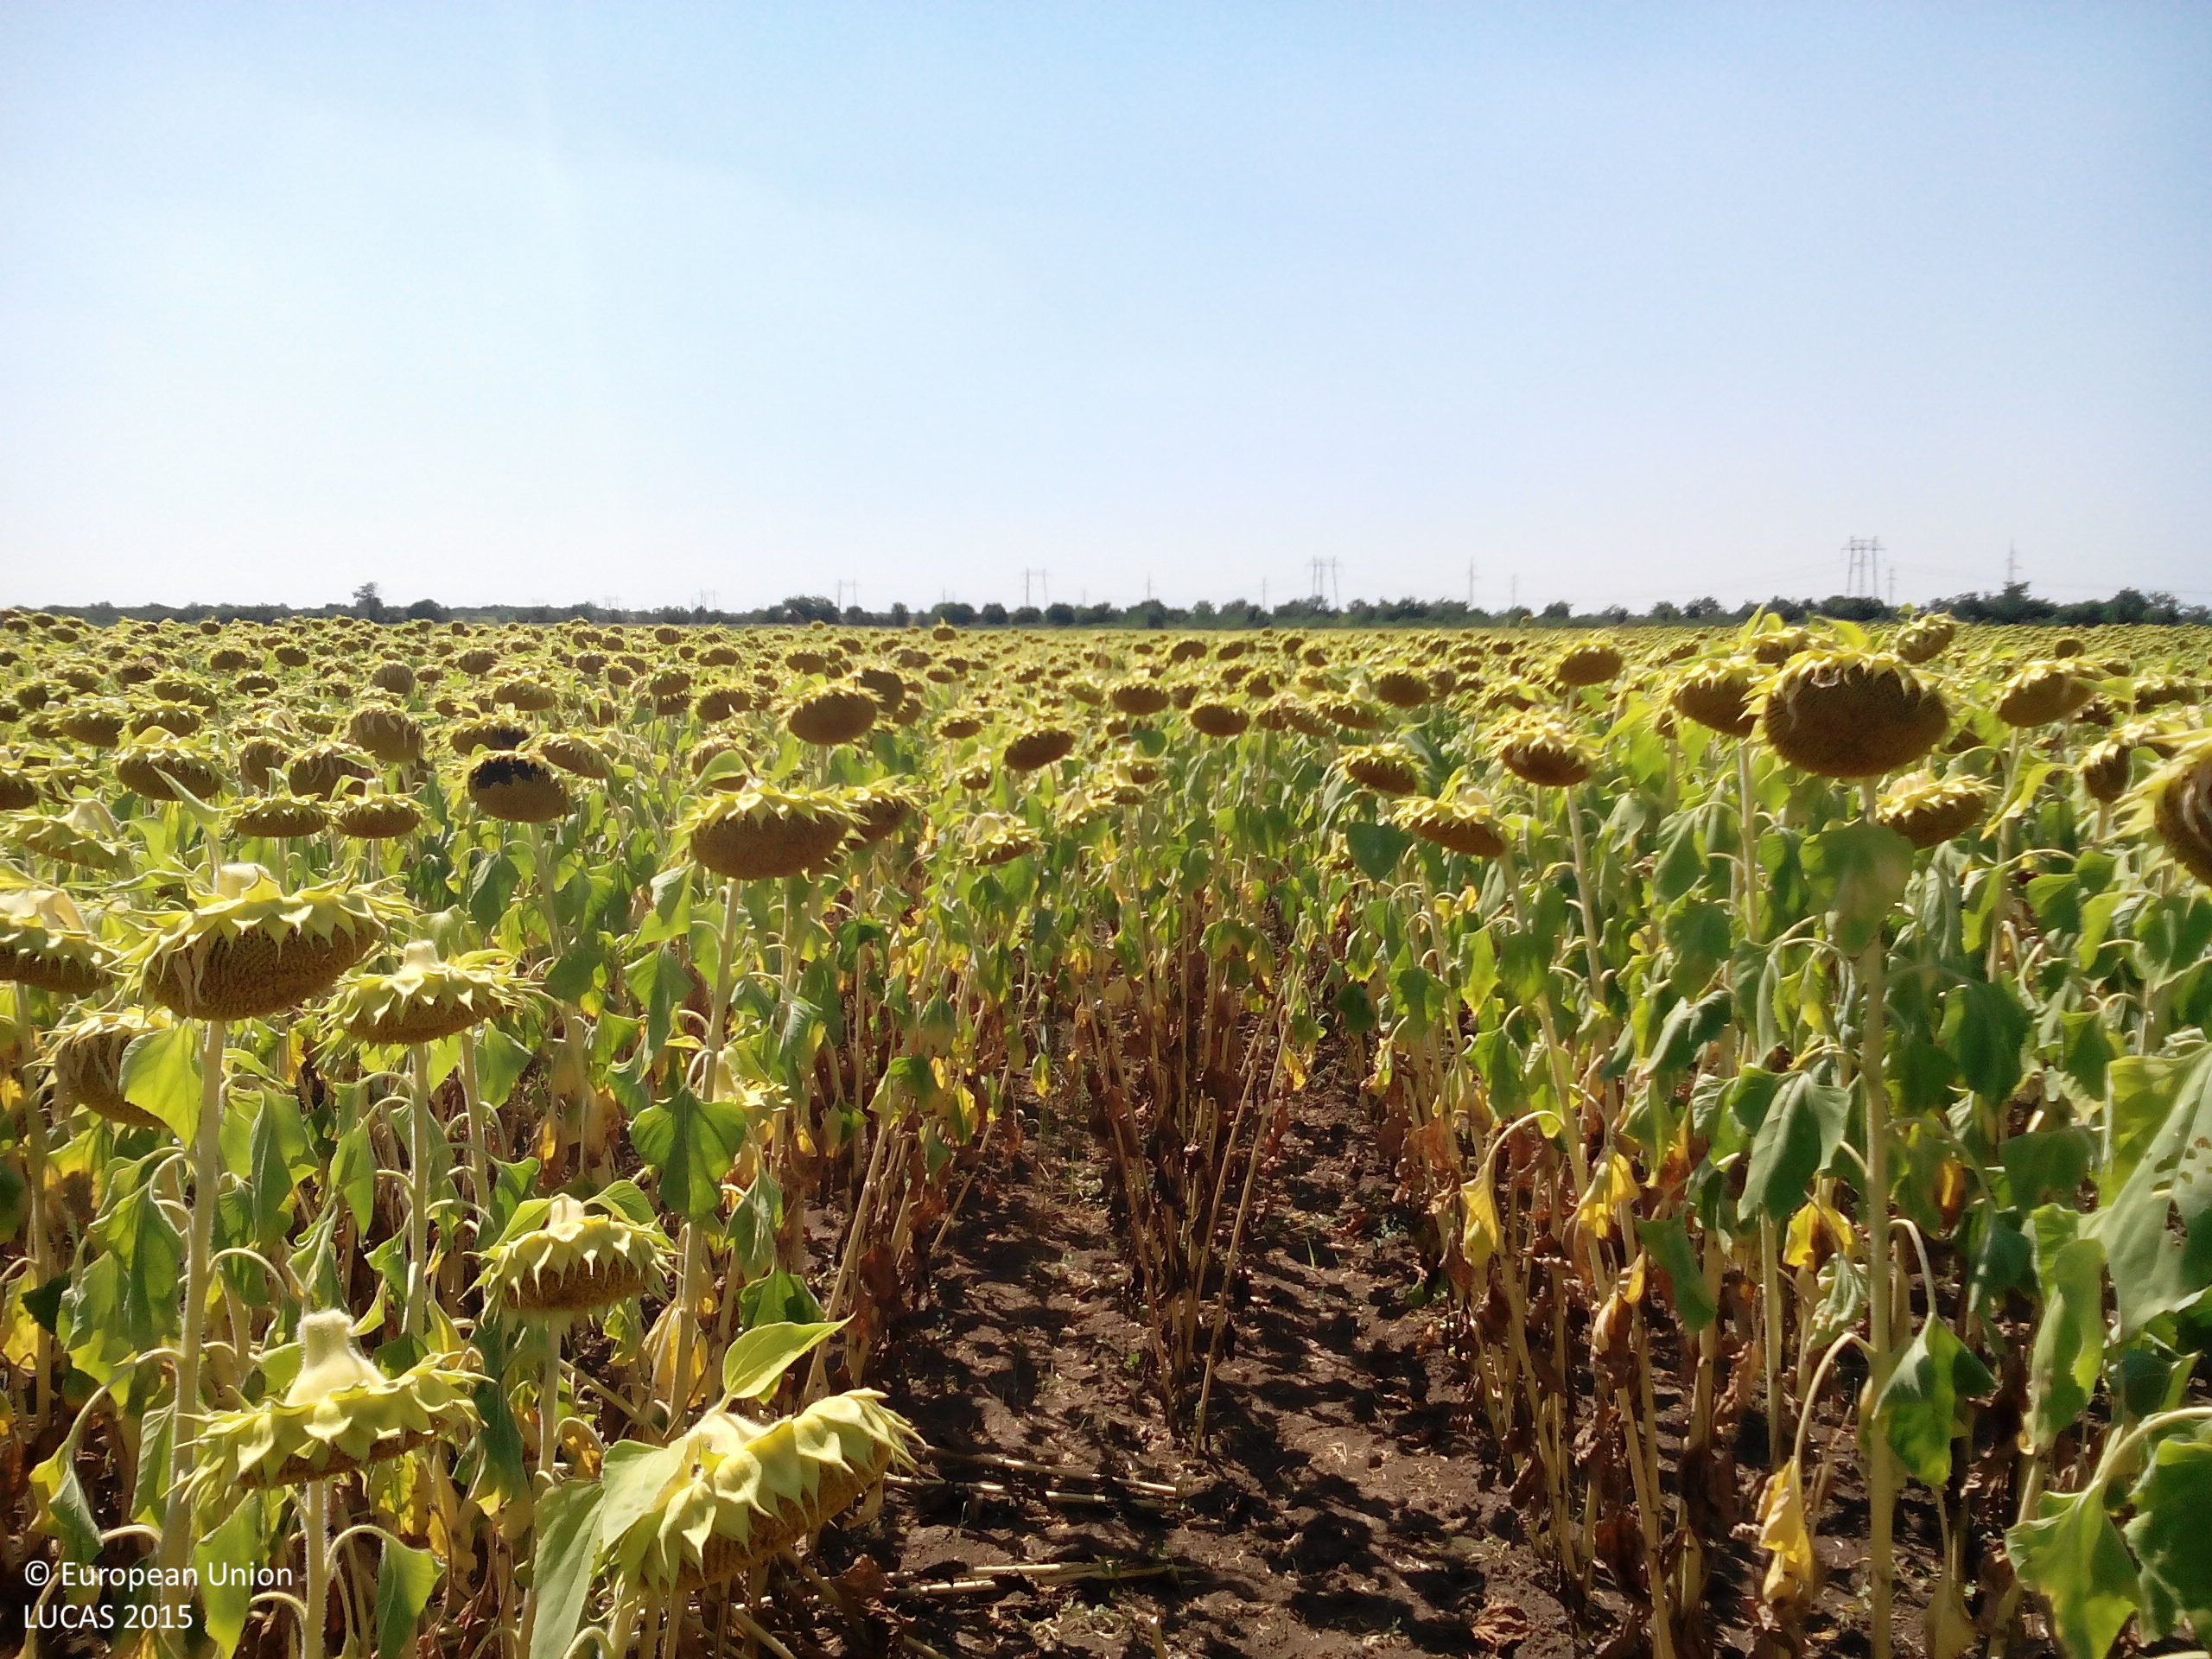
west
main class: Cropland
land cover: Sunflower
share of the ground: > 75 %
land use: Agriculture (excluding fallow land and kitchen gardens)
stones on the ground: < 10 %
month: July
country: BG
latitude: 43.3145
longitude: 24.3221
